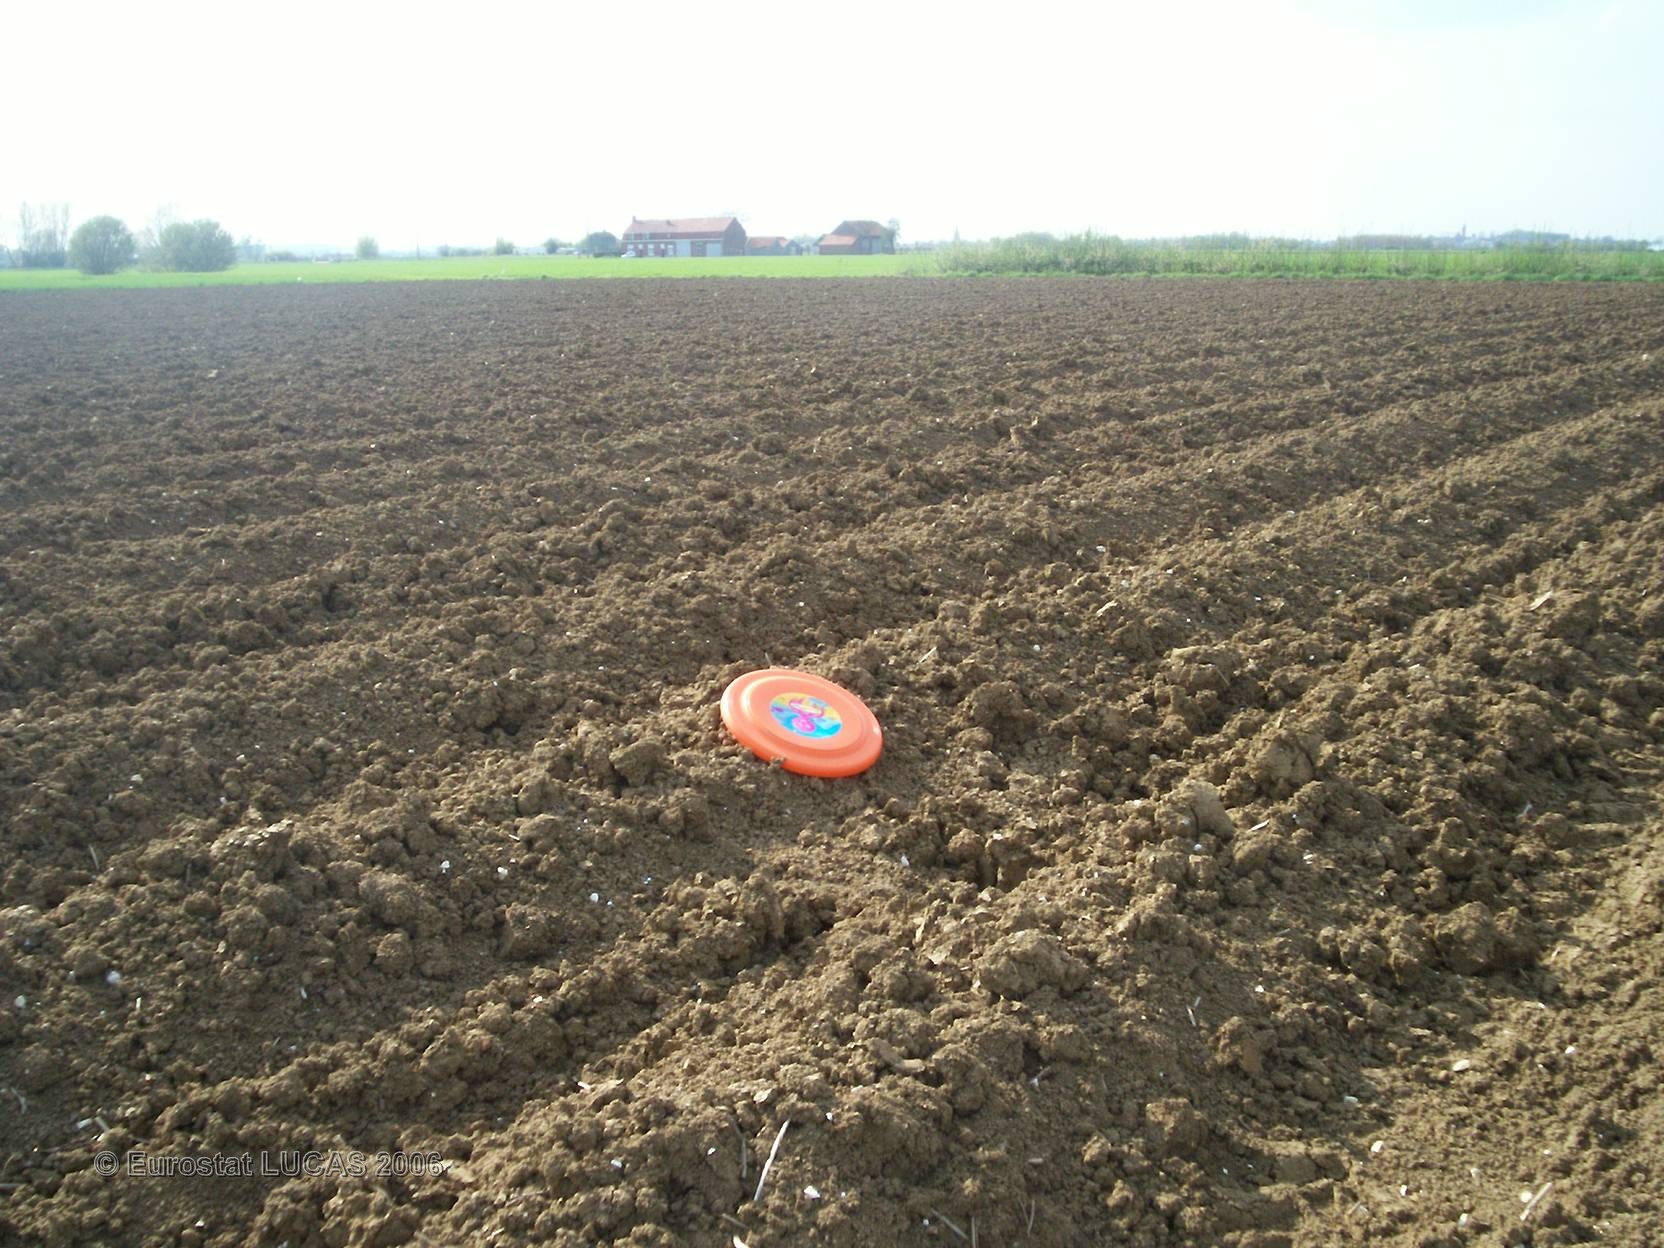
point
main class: Cropland
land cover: Potatoes
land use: Agriculture (excluding fallow land and kitchen gardens)
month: May
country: FR
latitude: 50.7009
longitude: 2.5828
